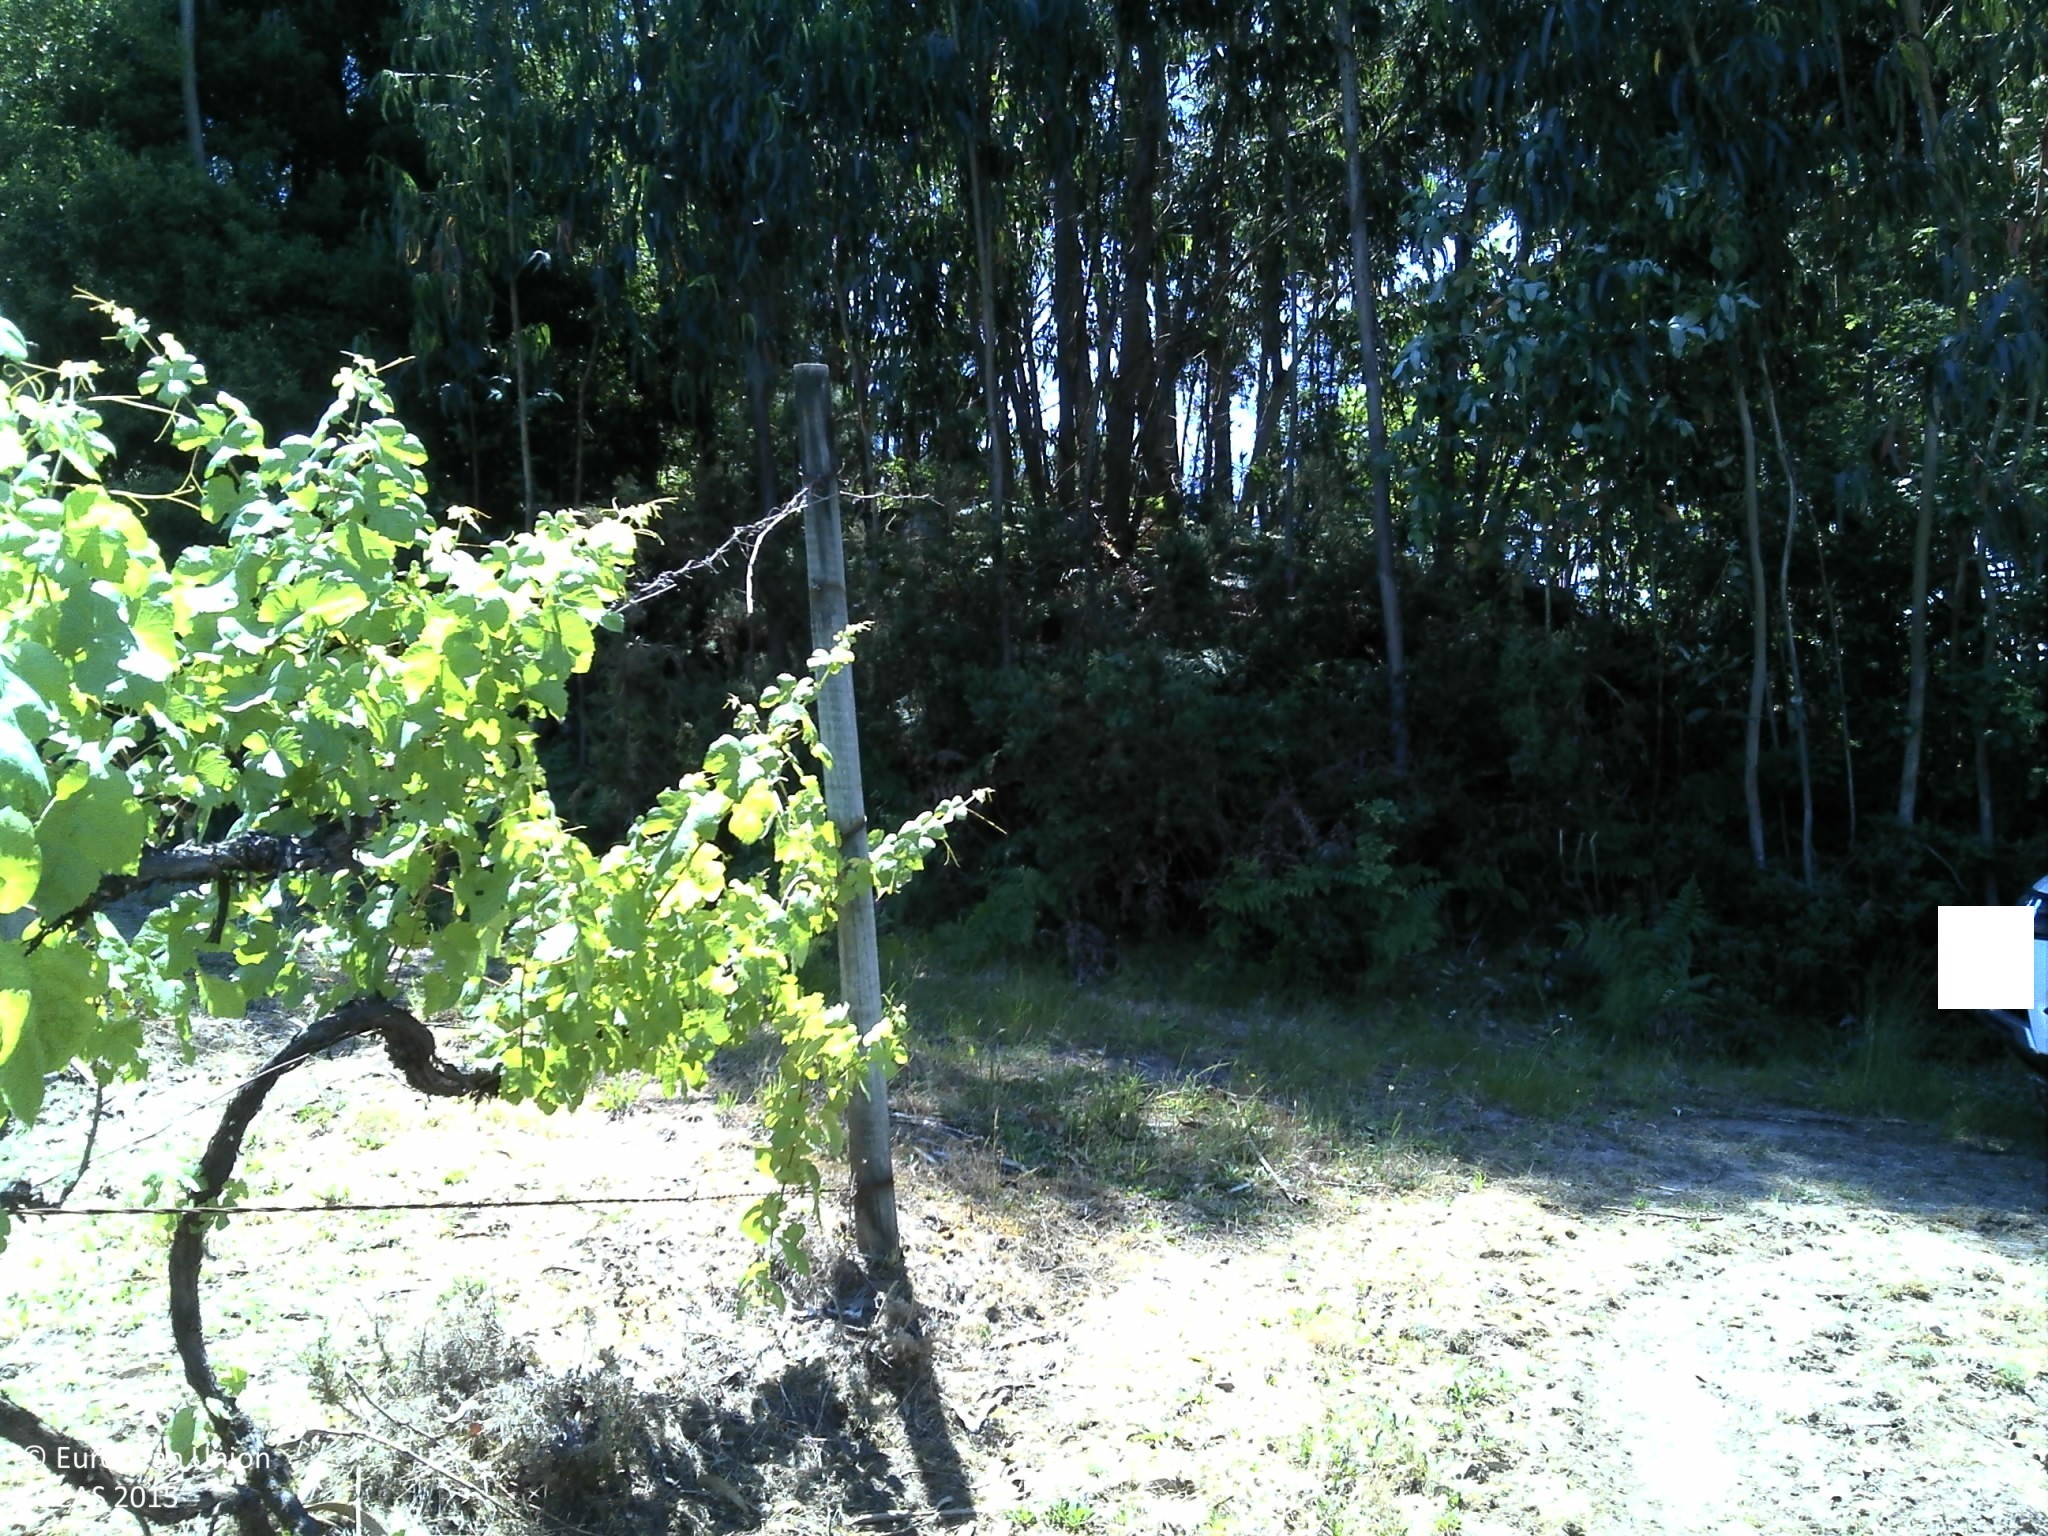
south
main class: Cropland
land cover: Vineyards
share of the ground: 10 - 25 %
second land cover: Spontaneously vegetated surfaces
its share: 10 - 25 %
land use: Agriculture (excluding fallow land and kitchen gardens)
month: May
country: PT
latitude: 41.7237
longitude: -8.6145
